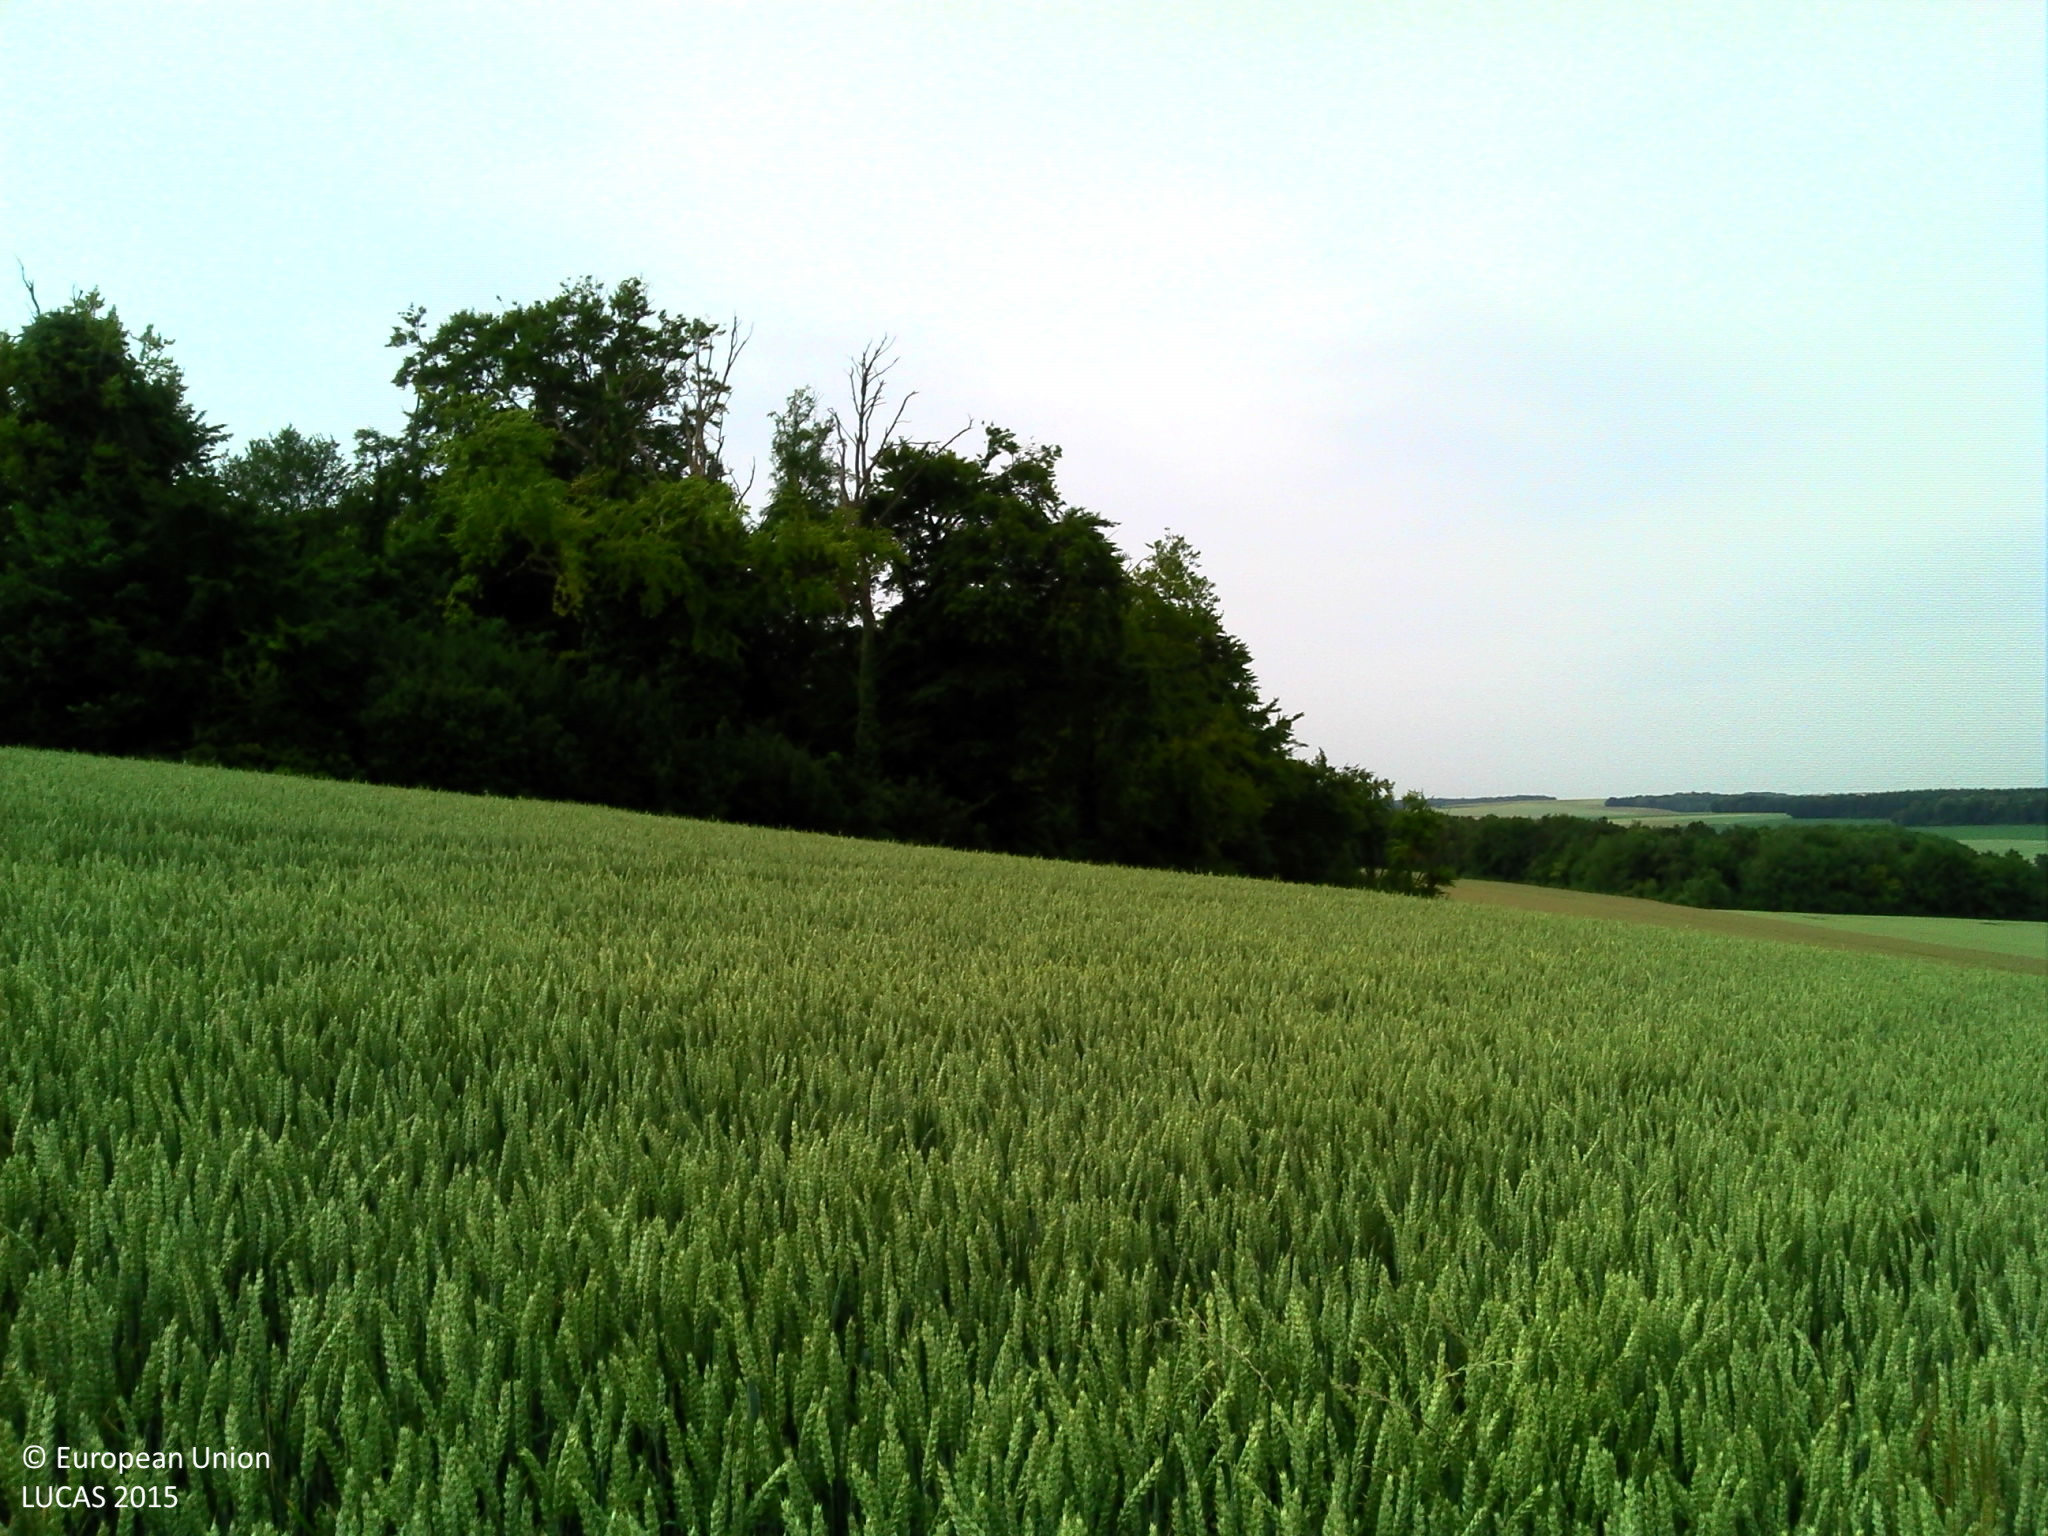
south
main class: Cropland
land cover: Common wheat
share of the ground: > 75 %
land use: Agriculture (excluding fallow land and kitchen gardens)
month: June
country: FR
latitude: 49.6403
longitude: 2.3848
